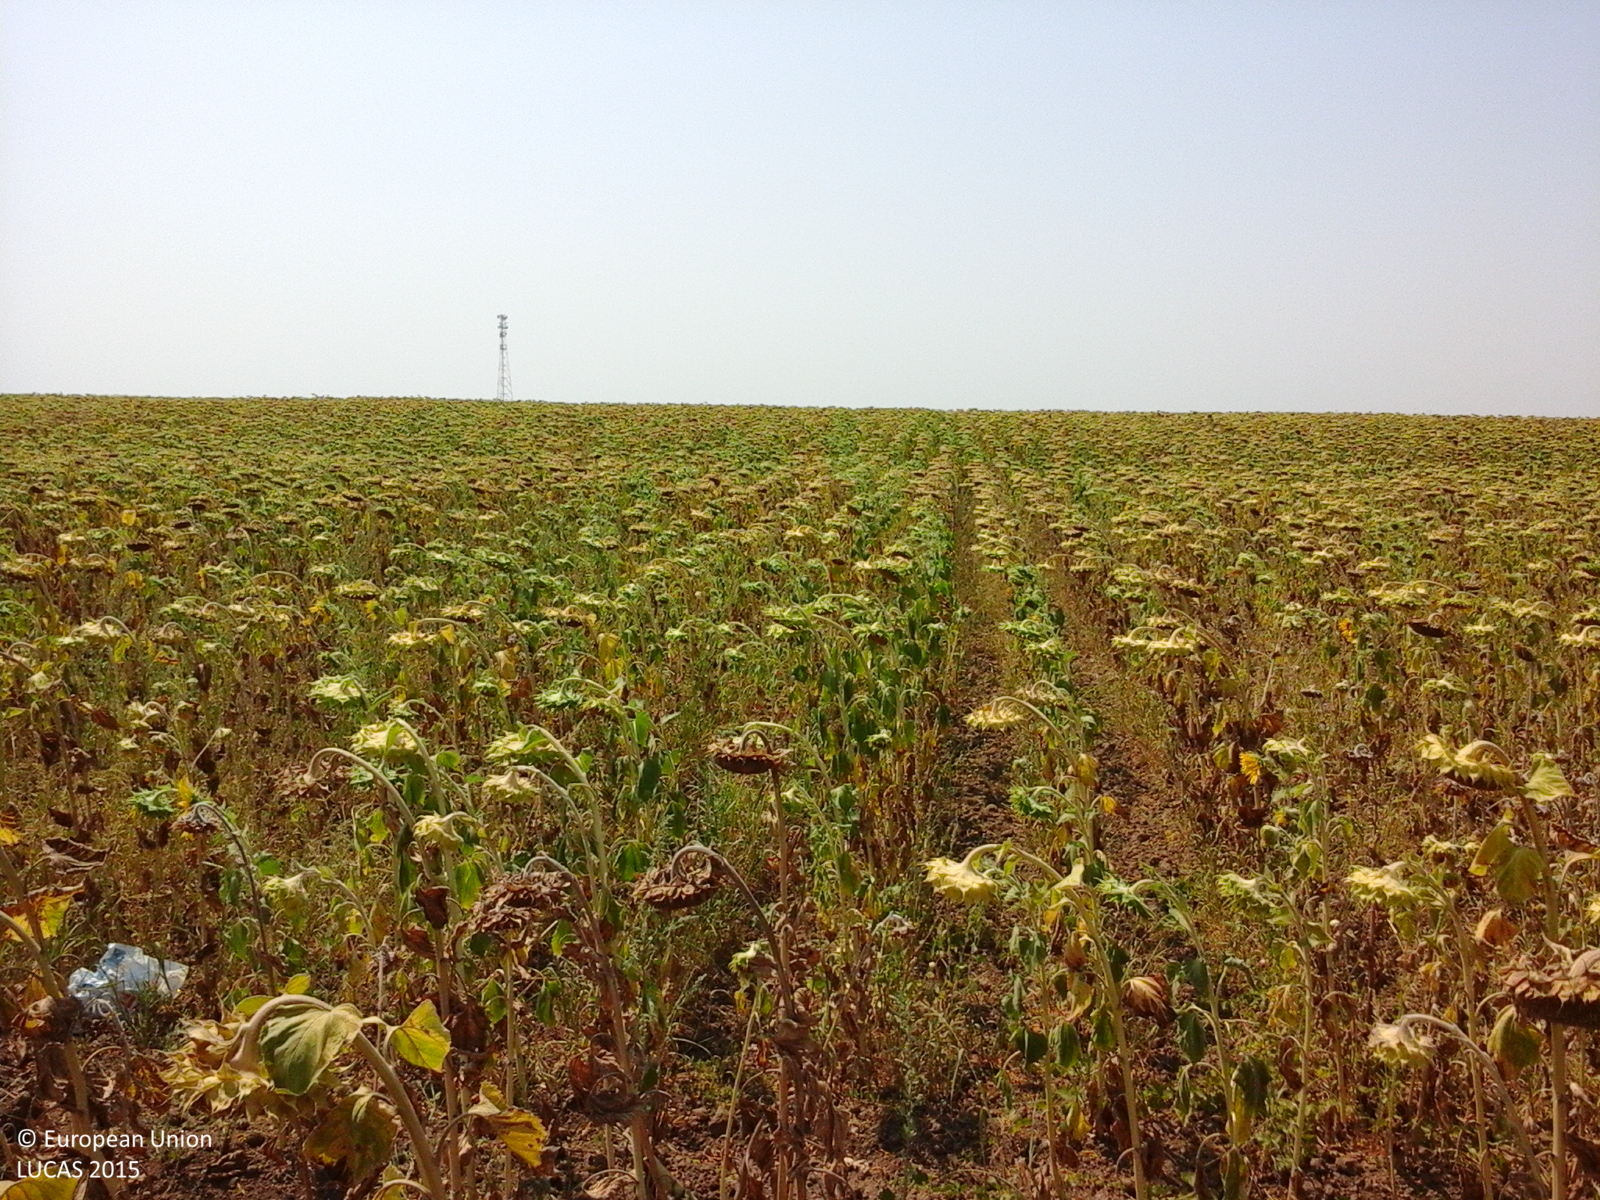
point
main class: Cropland
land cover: Sunflower
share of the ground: > 75 %
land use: Agriculture (excluding fallow land and kitchen gardens)
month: August
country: RO
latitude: 44.2650
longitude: 23.2379
